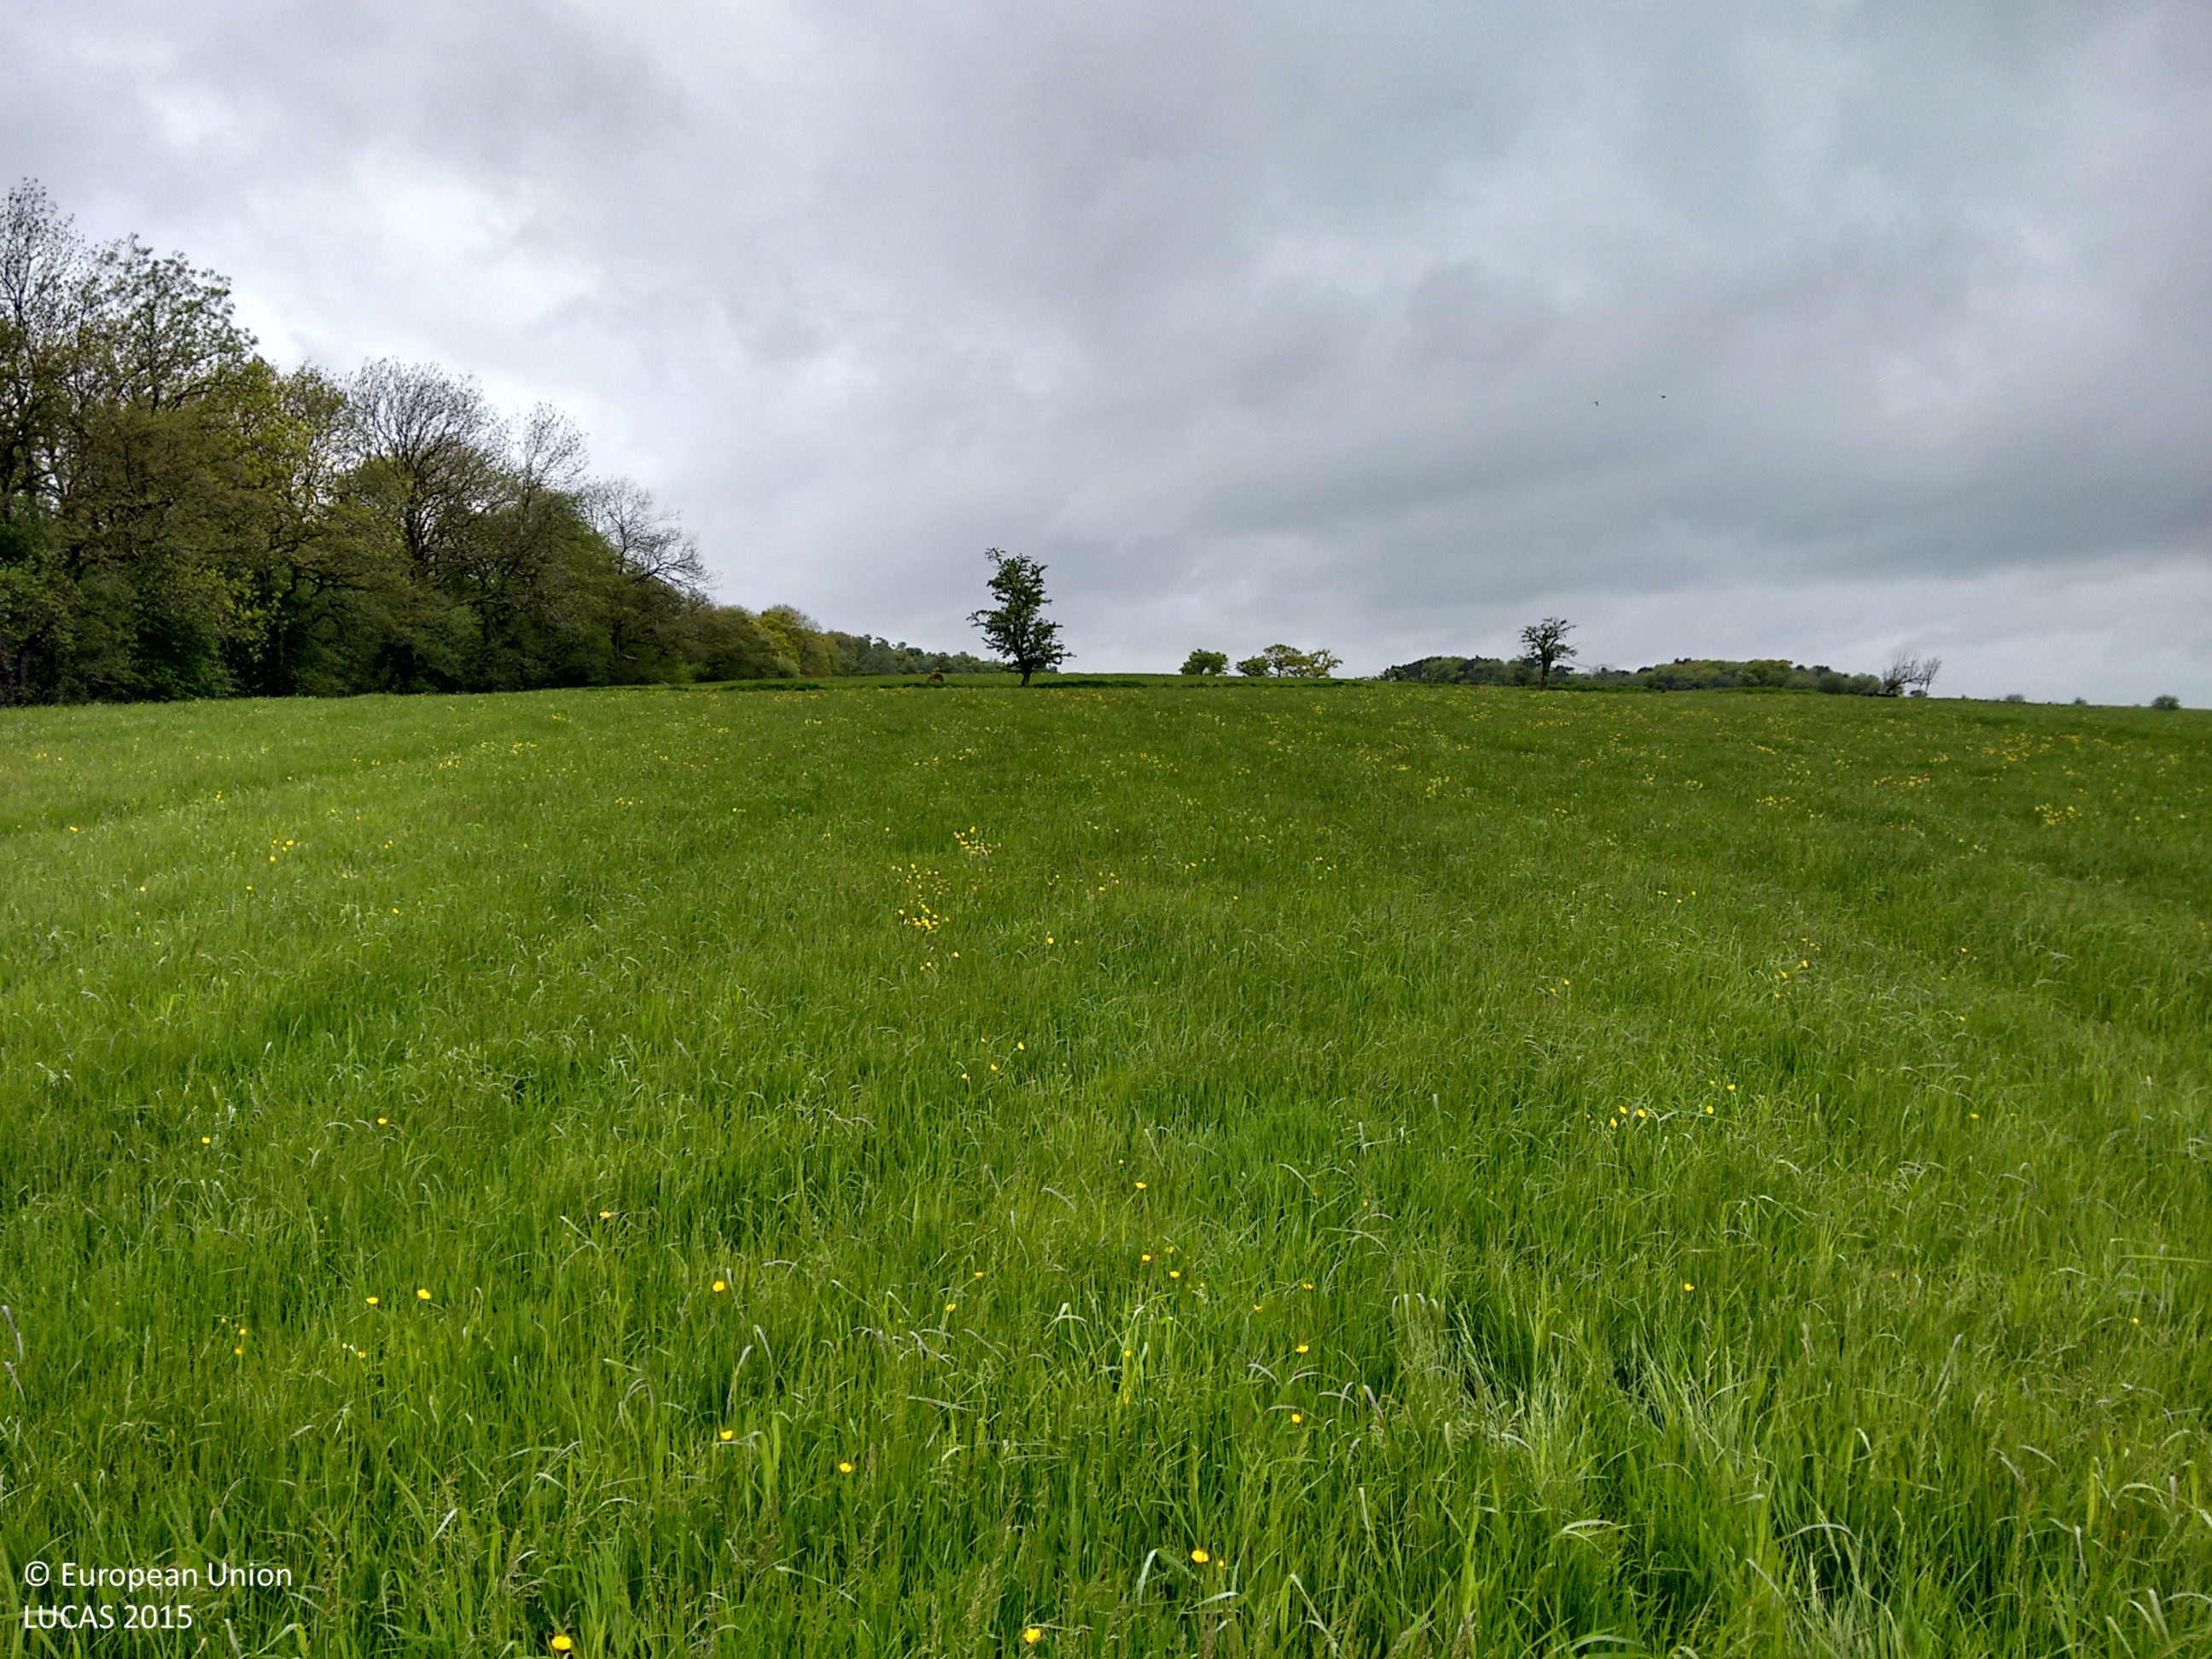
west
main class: Grassland
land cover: Grassland without tree/shrub cover
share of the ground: > 75 %
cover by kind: herbaceous plants 100 %
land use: Agriculture (excluding fallow land and kitchen gardens)
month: June
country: GB
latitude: 53.9757
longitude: -2.2737
